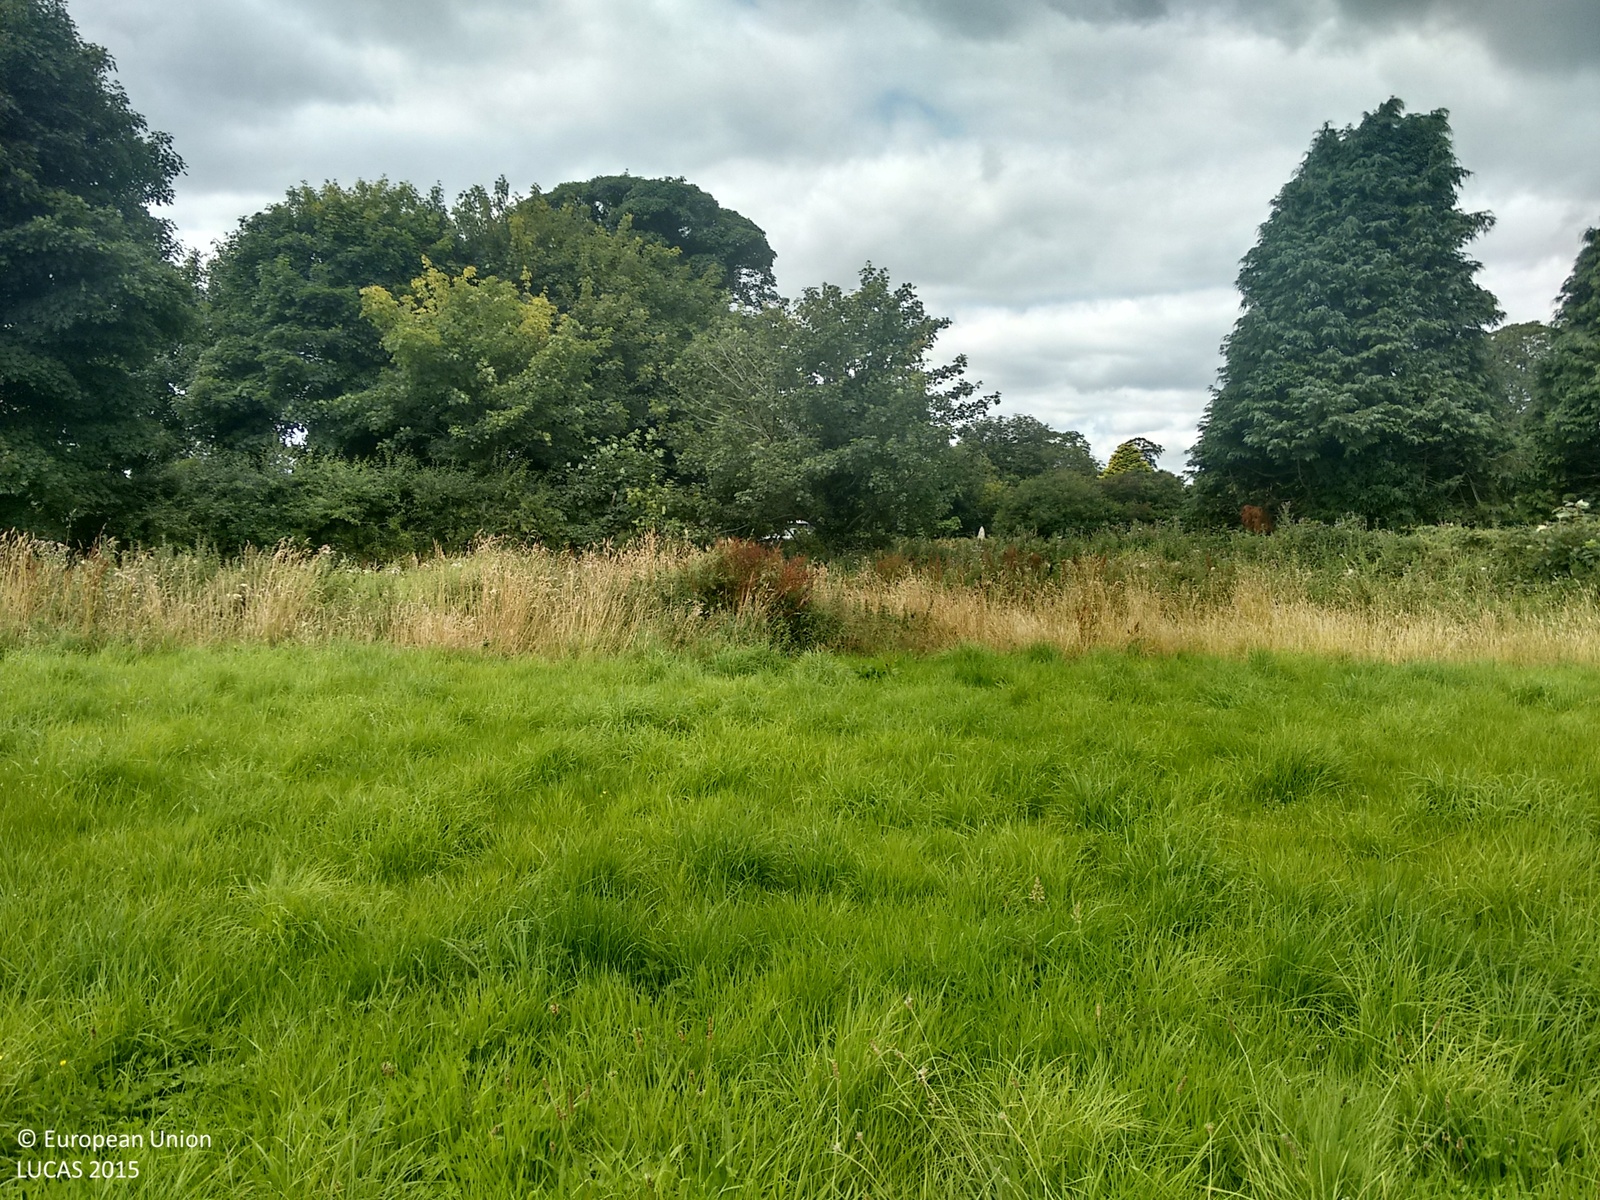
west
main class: Grassland
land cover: Grassland without tree/shrub cover
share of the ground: > 75 %
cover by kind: herbaceous plants 100 %
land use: Agriculture (excluding fallow land and kitchen gardens)
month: August
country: IE
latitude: 53.8000
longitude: -6.3835
